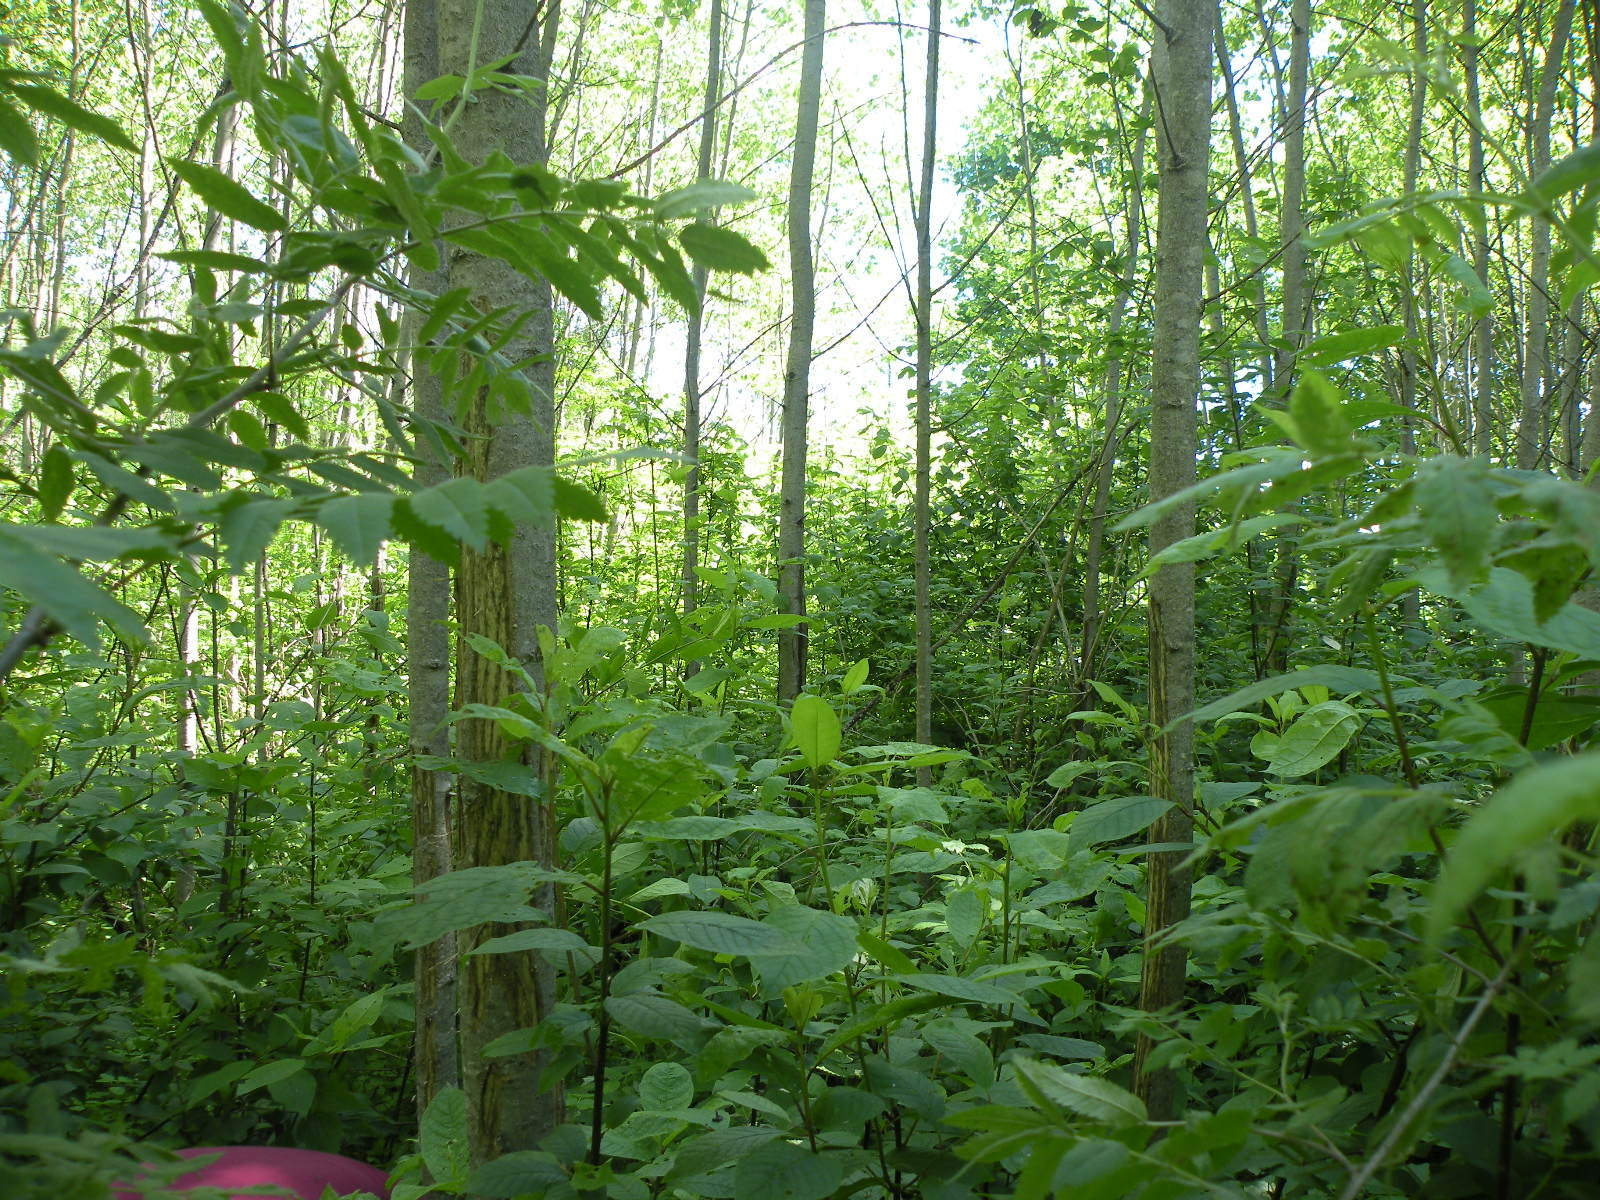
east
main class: Woodland
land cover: Broadleaved woodland
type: non-riverine alder, birch or aspen forest
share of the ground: > 75 %
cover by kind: broadleaved forest trees 85 %, herbaceous plants 10 %, shrubs 5 %
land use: Forestry
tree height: > 5 m
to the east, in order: Broadleaved woodland; Grassland without tree/shrub cover; Broadleaved woodland
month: May
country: LV
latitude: 55.9950
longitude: 26.1899
